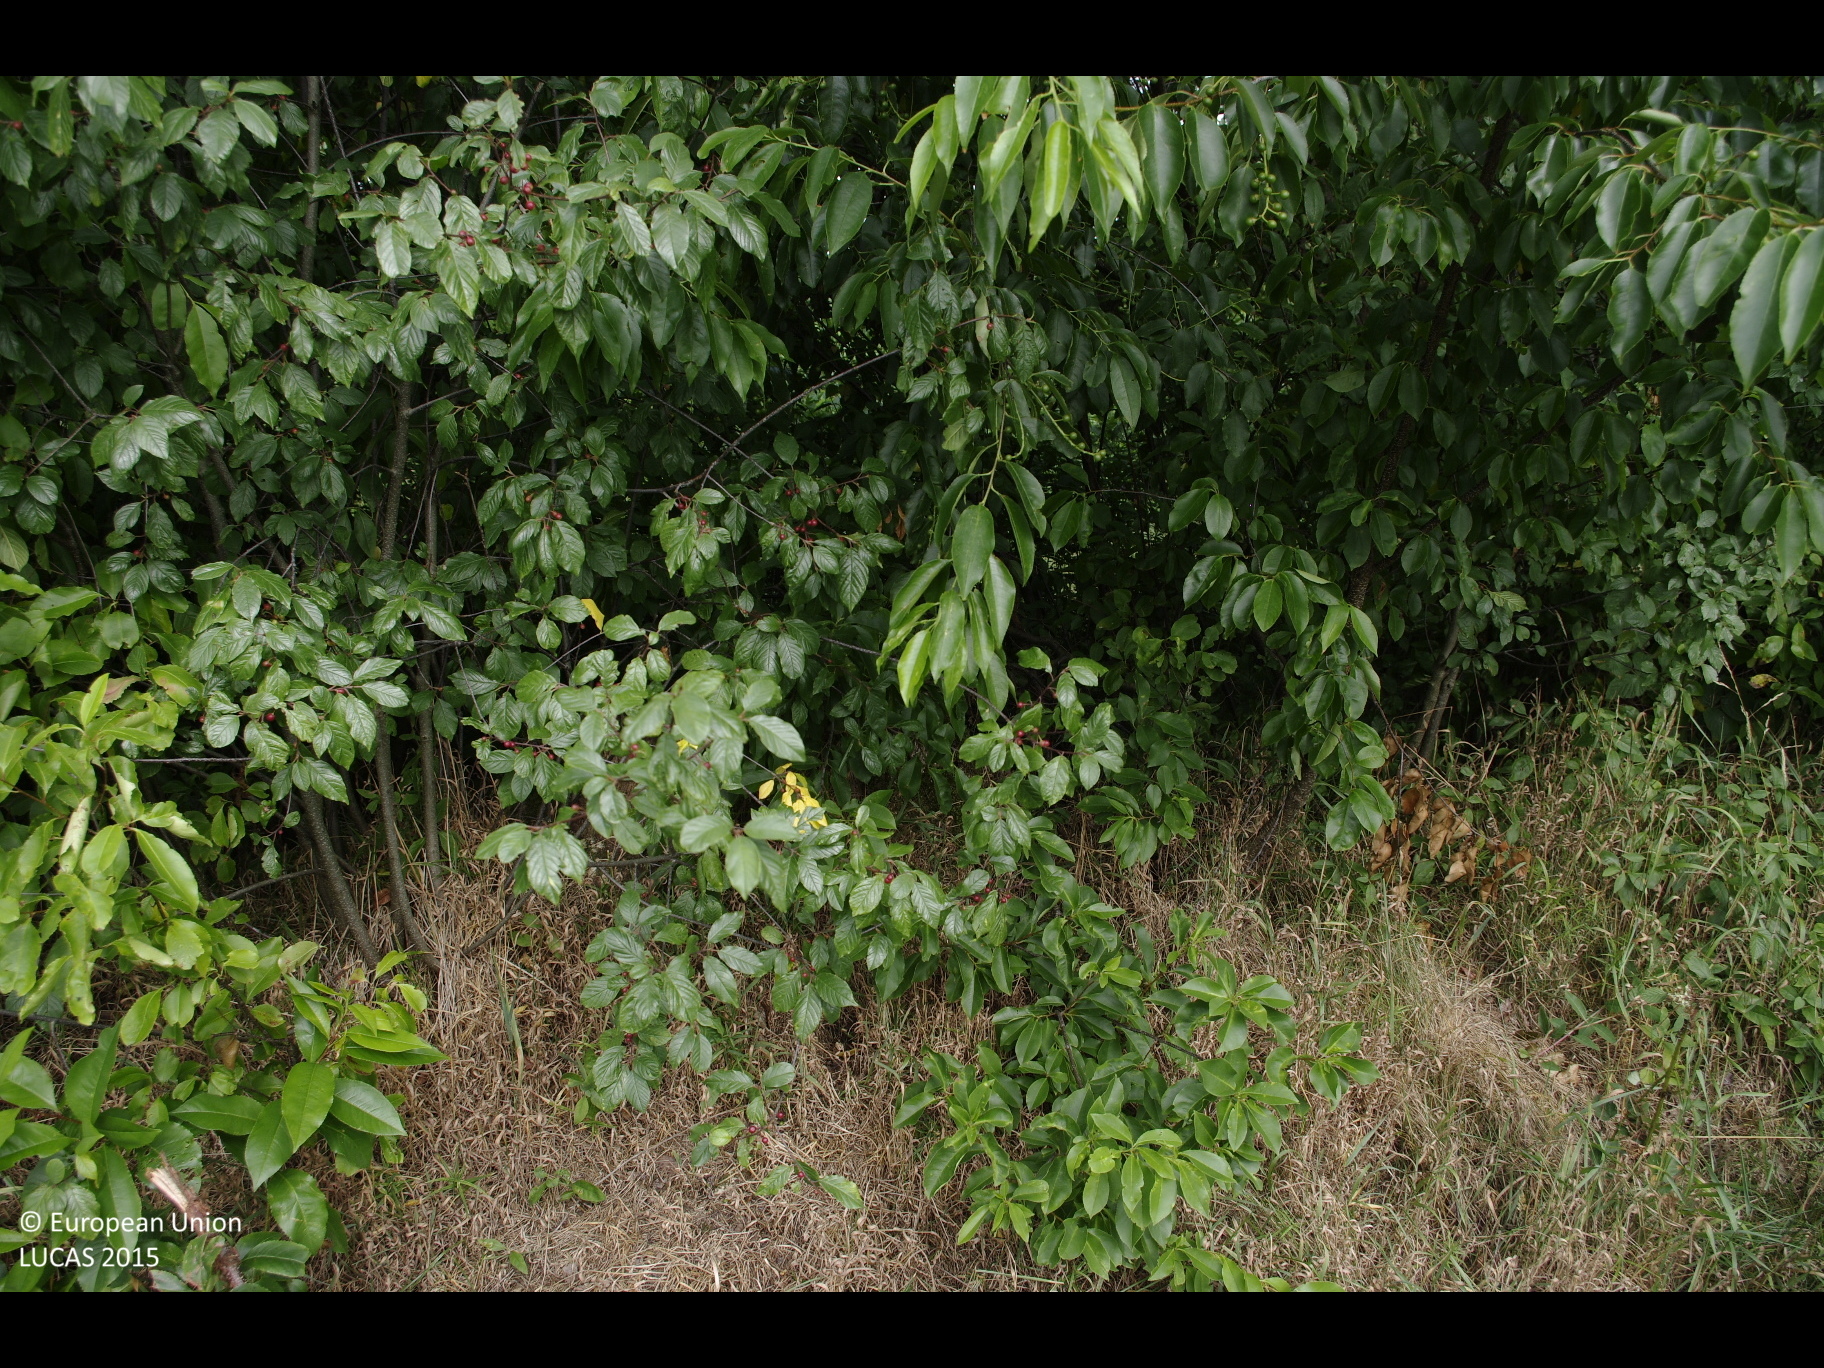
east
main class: Cropland
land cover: Maize
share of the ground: > 75 %
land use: Agriculture (excluding fallow land and kitchen gardens)
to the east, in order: Maize; Abandoned hedges; Tracks; Broadleaved woodland; Maize
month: July
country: DE
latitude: 53.9950
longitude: 9.9543
